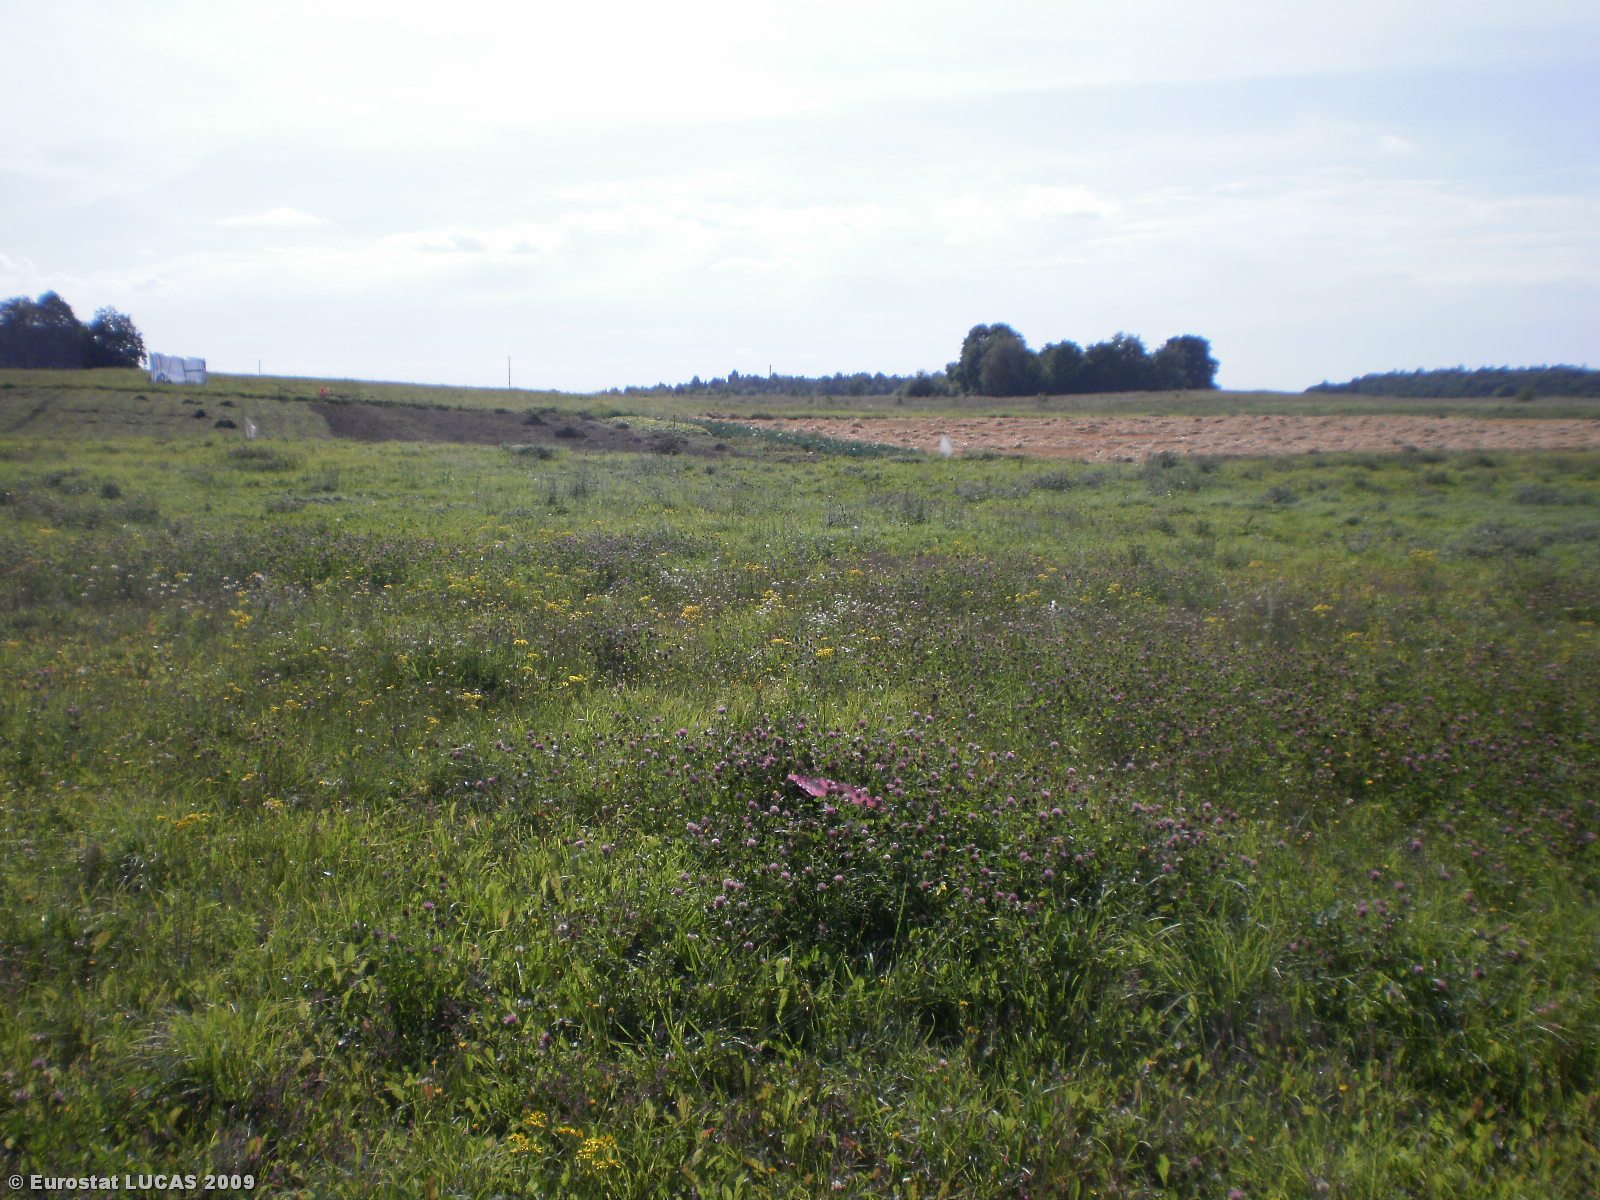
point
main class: Grassland
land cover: Grassland without tree/shrub cover
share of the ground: > 75 %
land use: Agriculture (excluding fallow land and kitchen gardens)
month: August
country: LT
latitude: 54.9288
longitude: 24.5697
